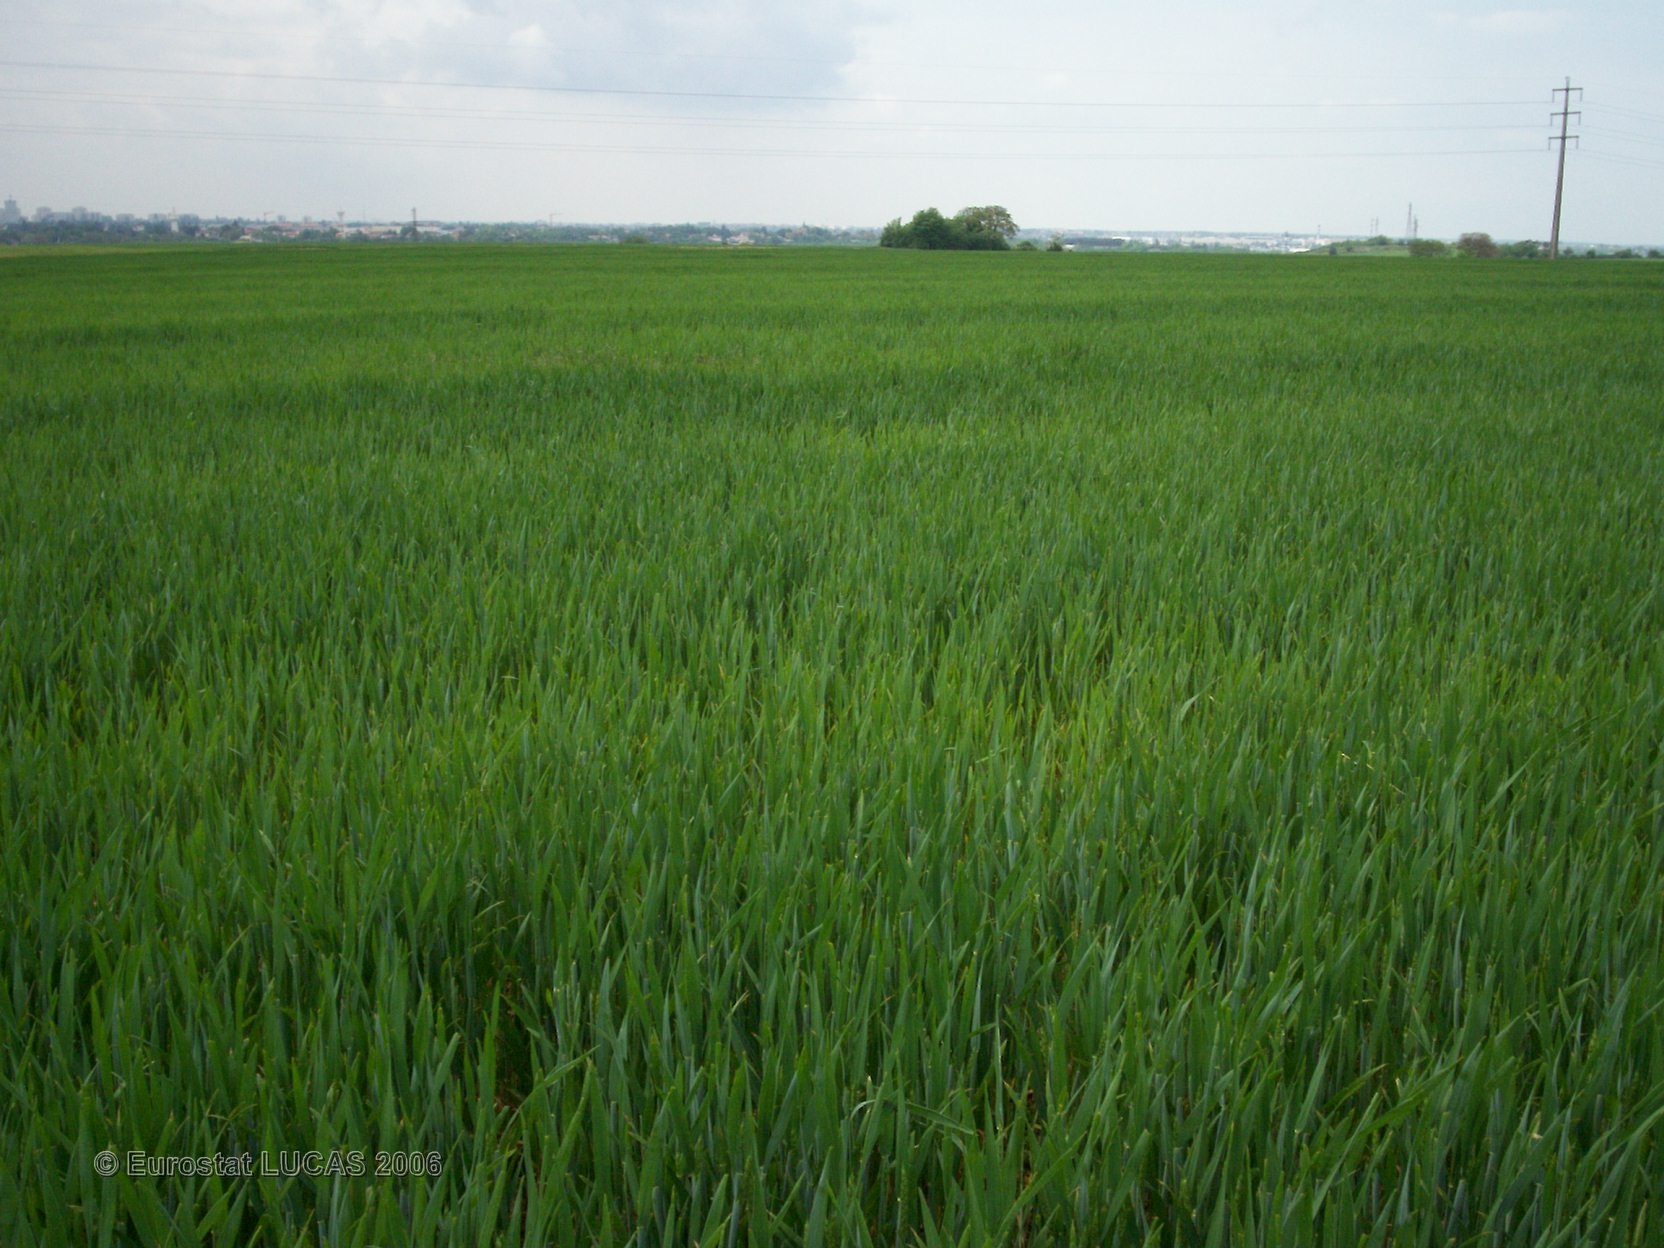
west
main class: Cropland
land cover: Common wheat
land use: Agriculture (excluding fallow land and kitchen gardens)
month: May
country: FR
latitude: 46.6240
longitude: 0.3820
